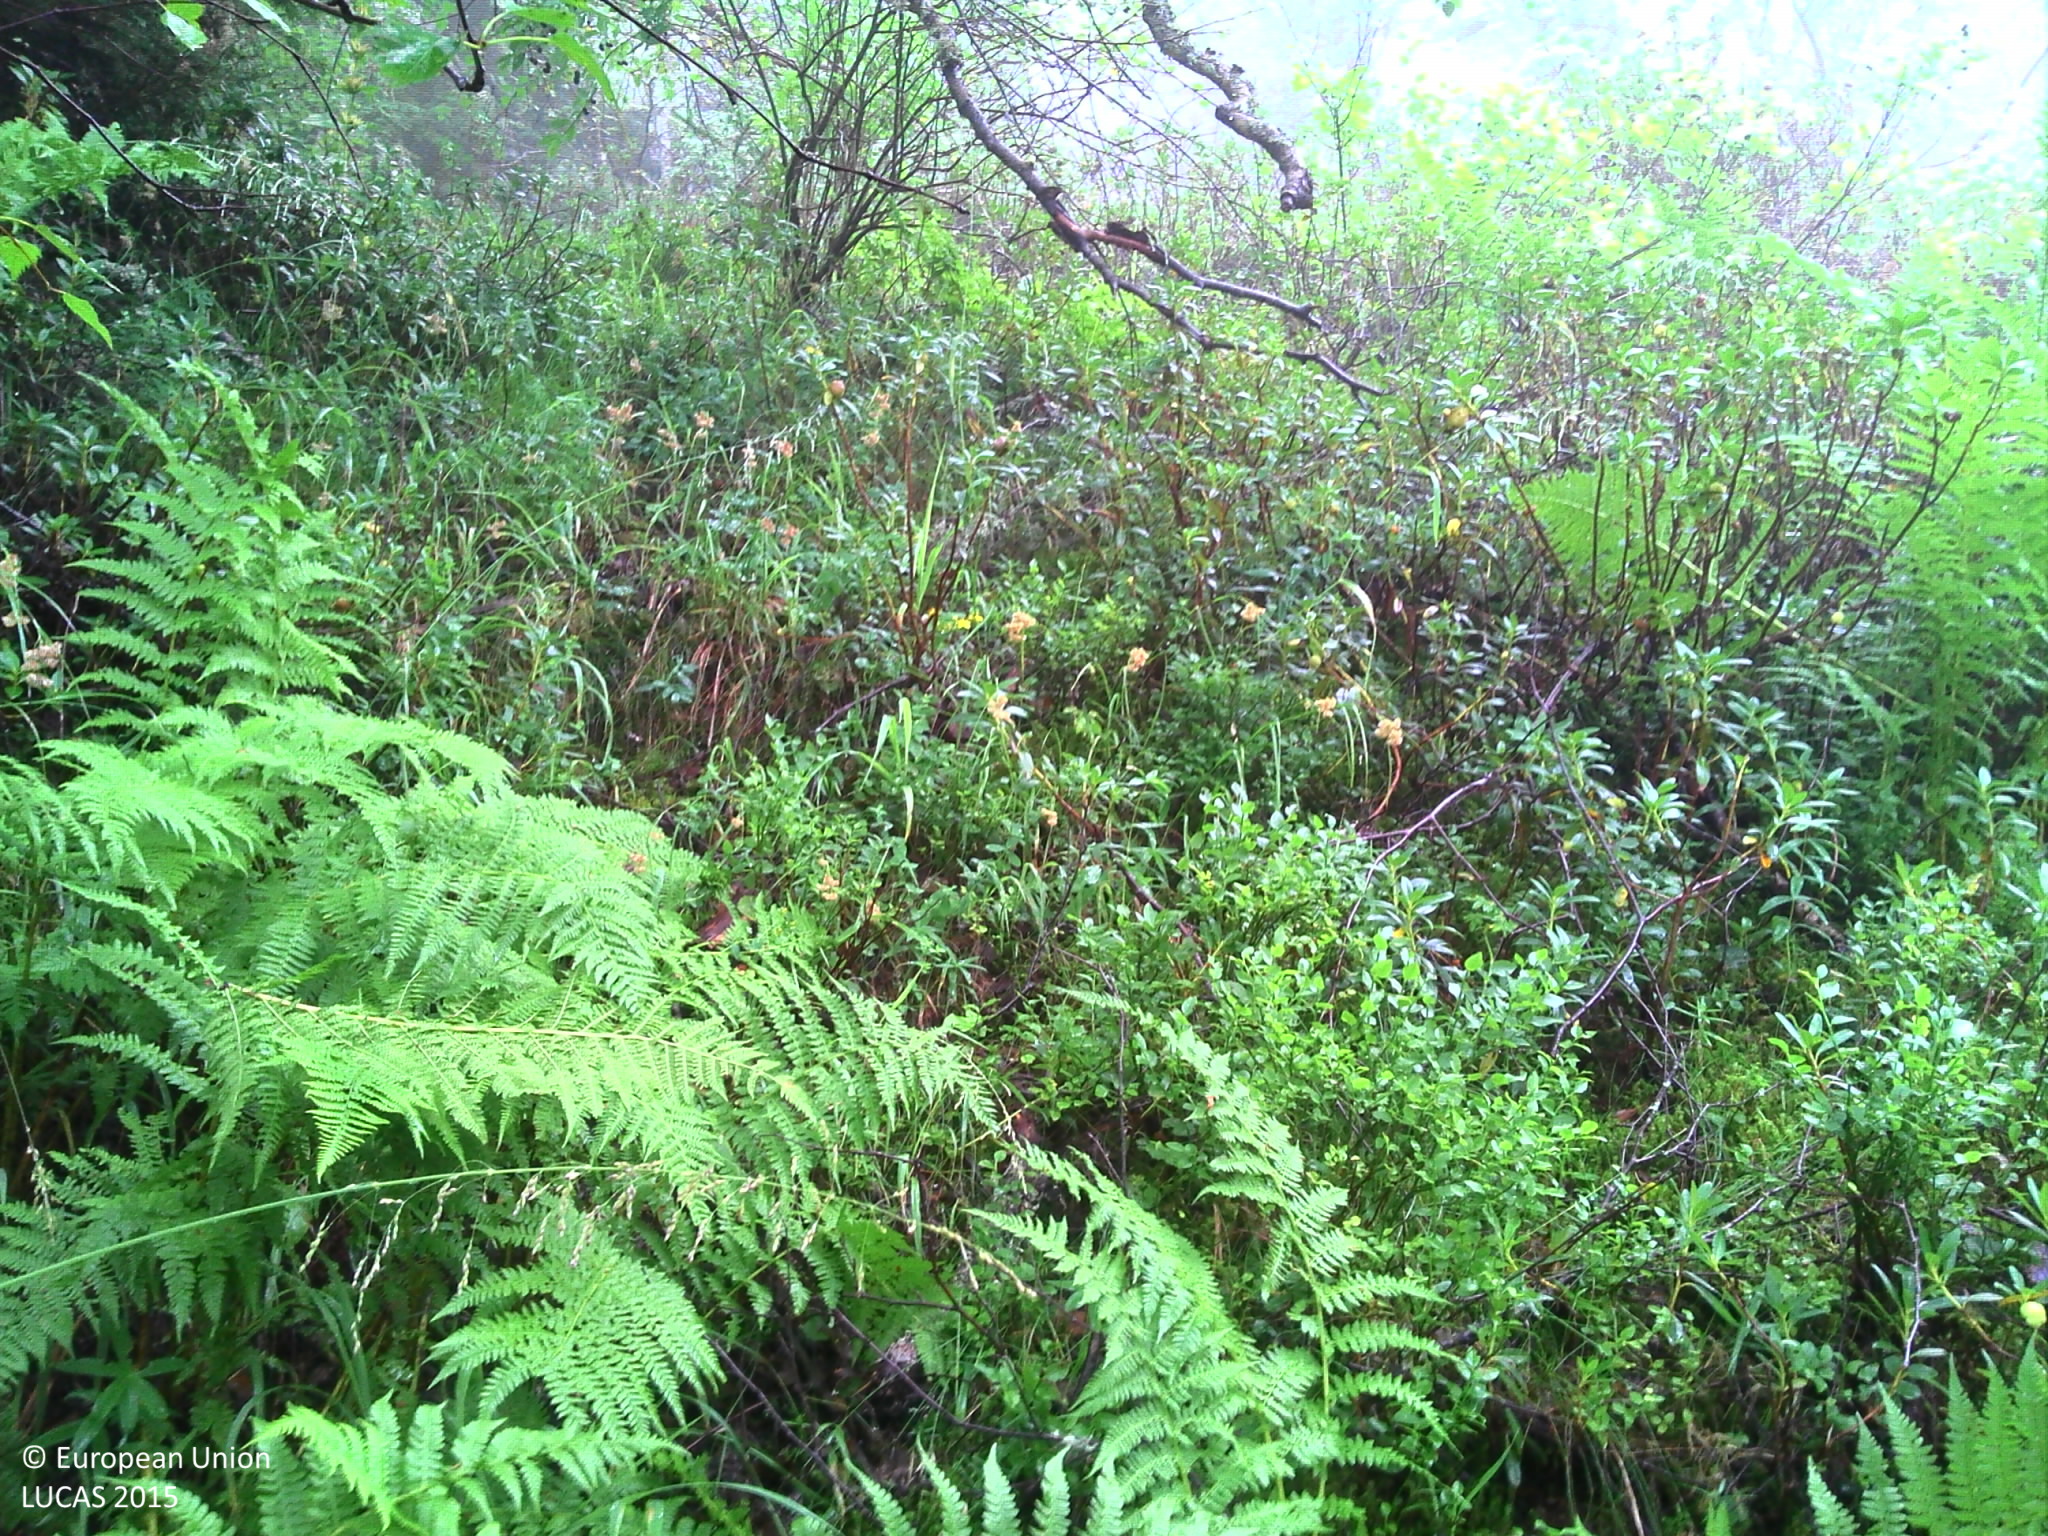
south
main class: Woodland
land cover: Spruce dominated mixed woodland
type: mountainous beech forest
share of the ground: > 75 %
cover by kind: broadleaved forest trees 45 %, herbaceous plants 40 %, coniferous forest trees 15 %
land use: Semi-natural and natural areas not in use
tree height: > 5 m
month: August
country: FR
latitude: 42.7295
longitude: 1.6913
